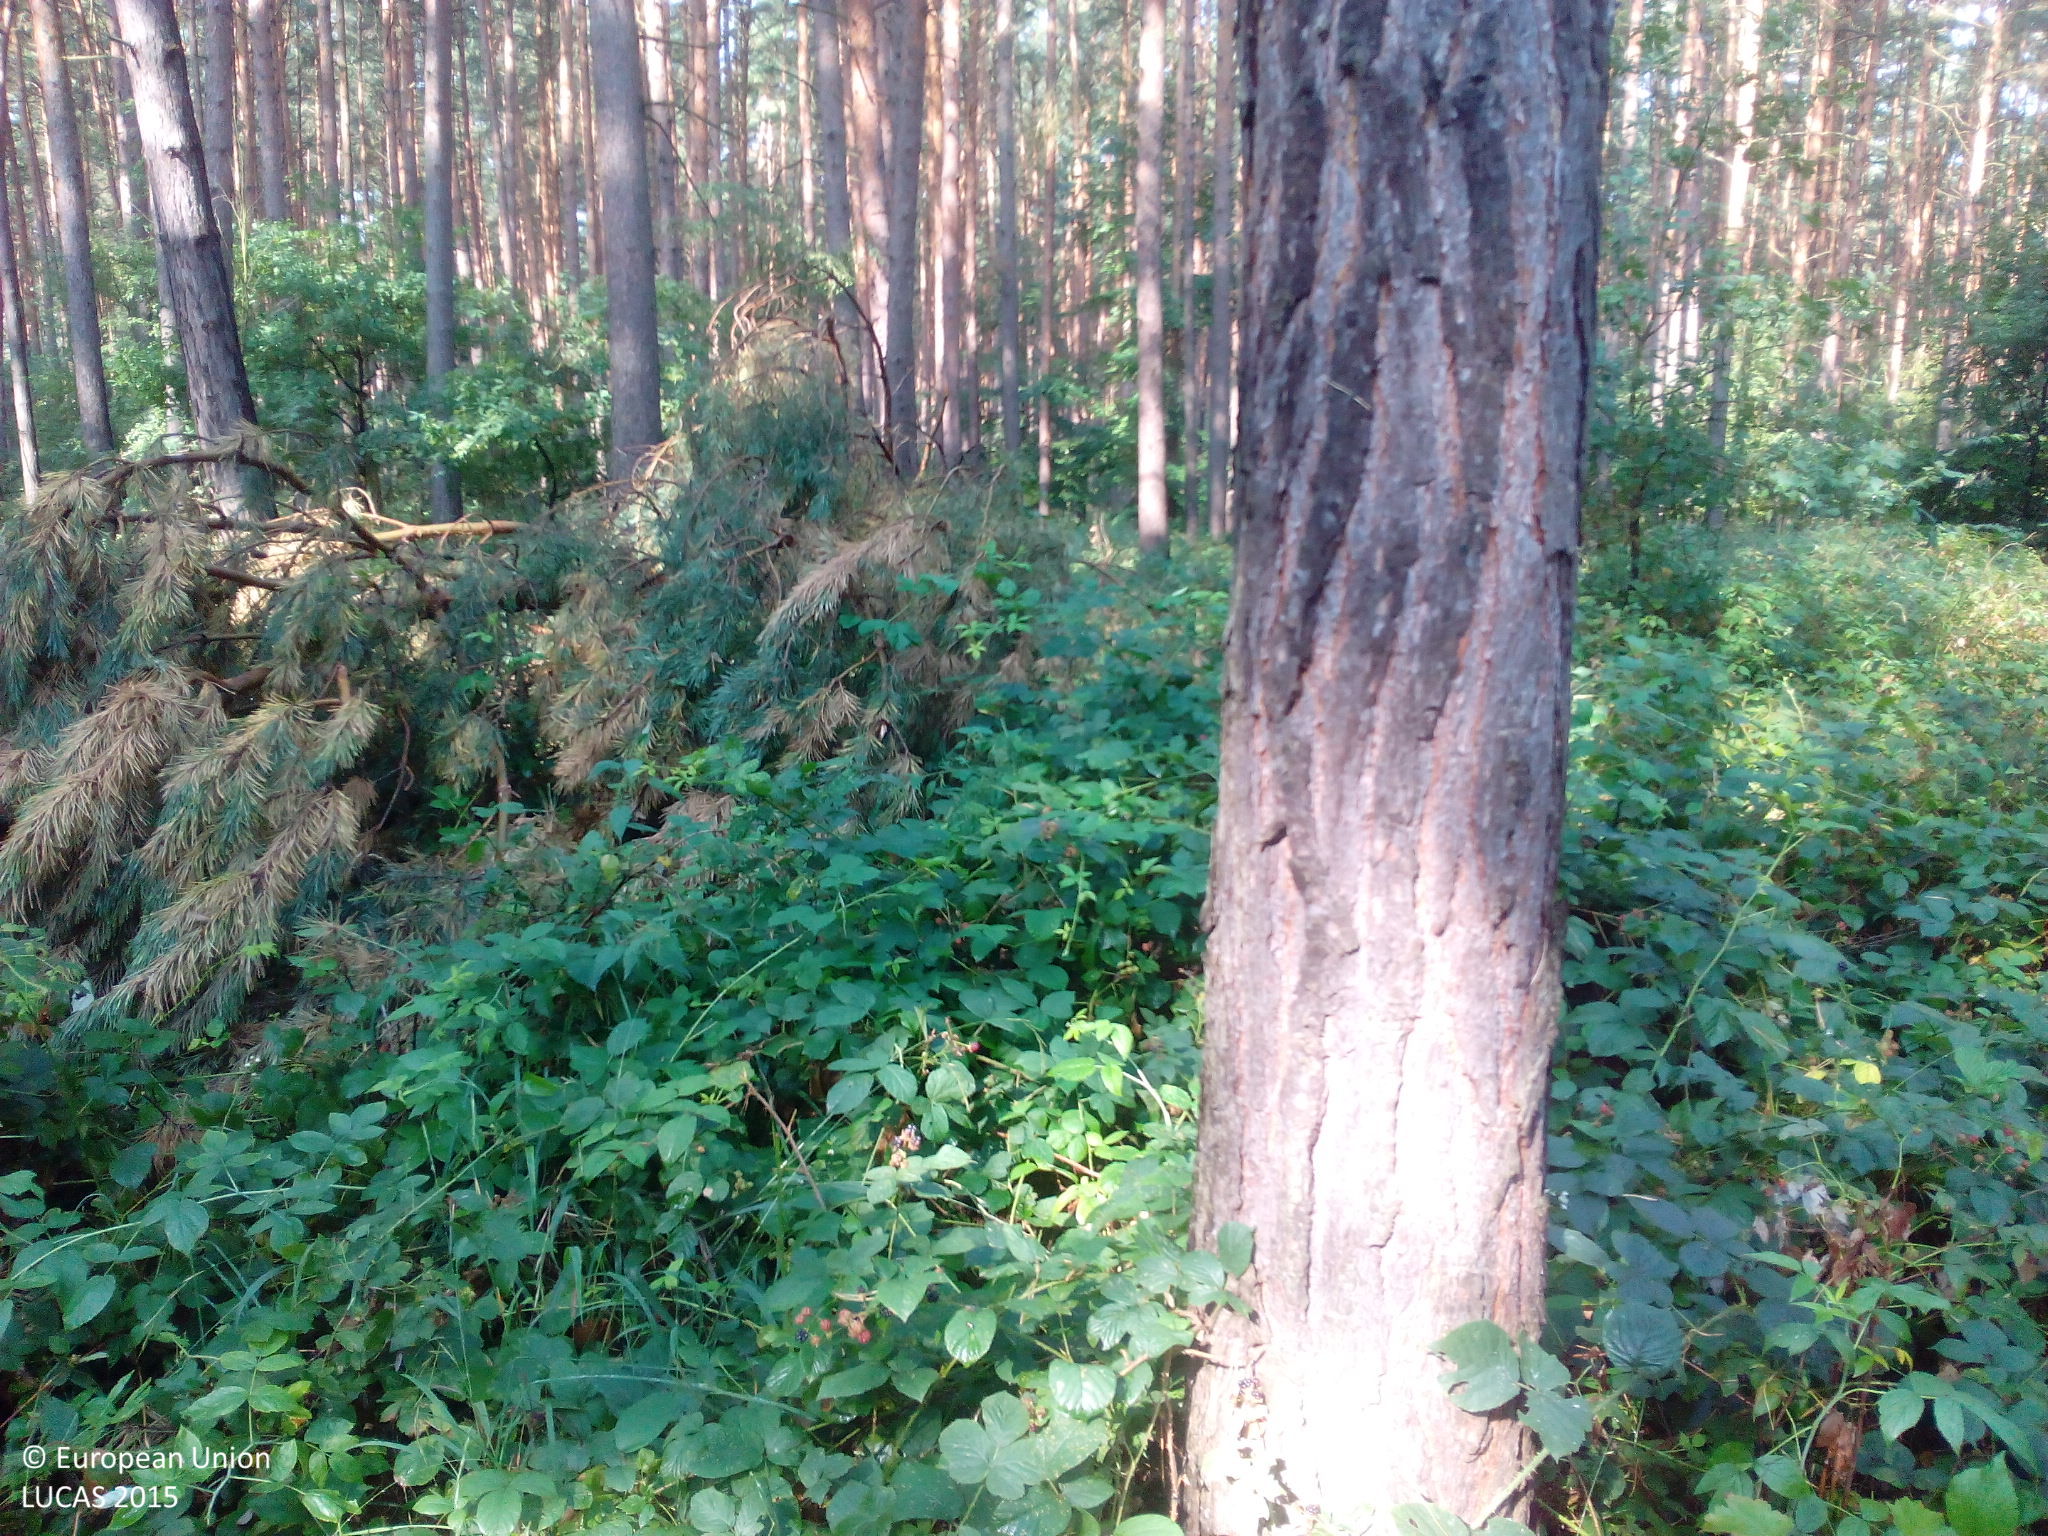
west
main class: Woodland
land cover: Pine dominated coniferous woodland
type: hemiboreal forest and nemoral coniferous forest and mixed broadleaved-coniferous forest
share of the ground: > 75 %
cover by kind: coniferous forest trees 90 %, shrubs 10 %
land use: Forestry
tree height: > 5 m
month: August
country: DE
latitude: 51.6857
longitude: 12.5021
